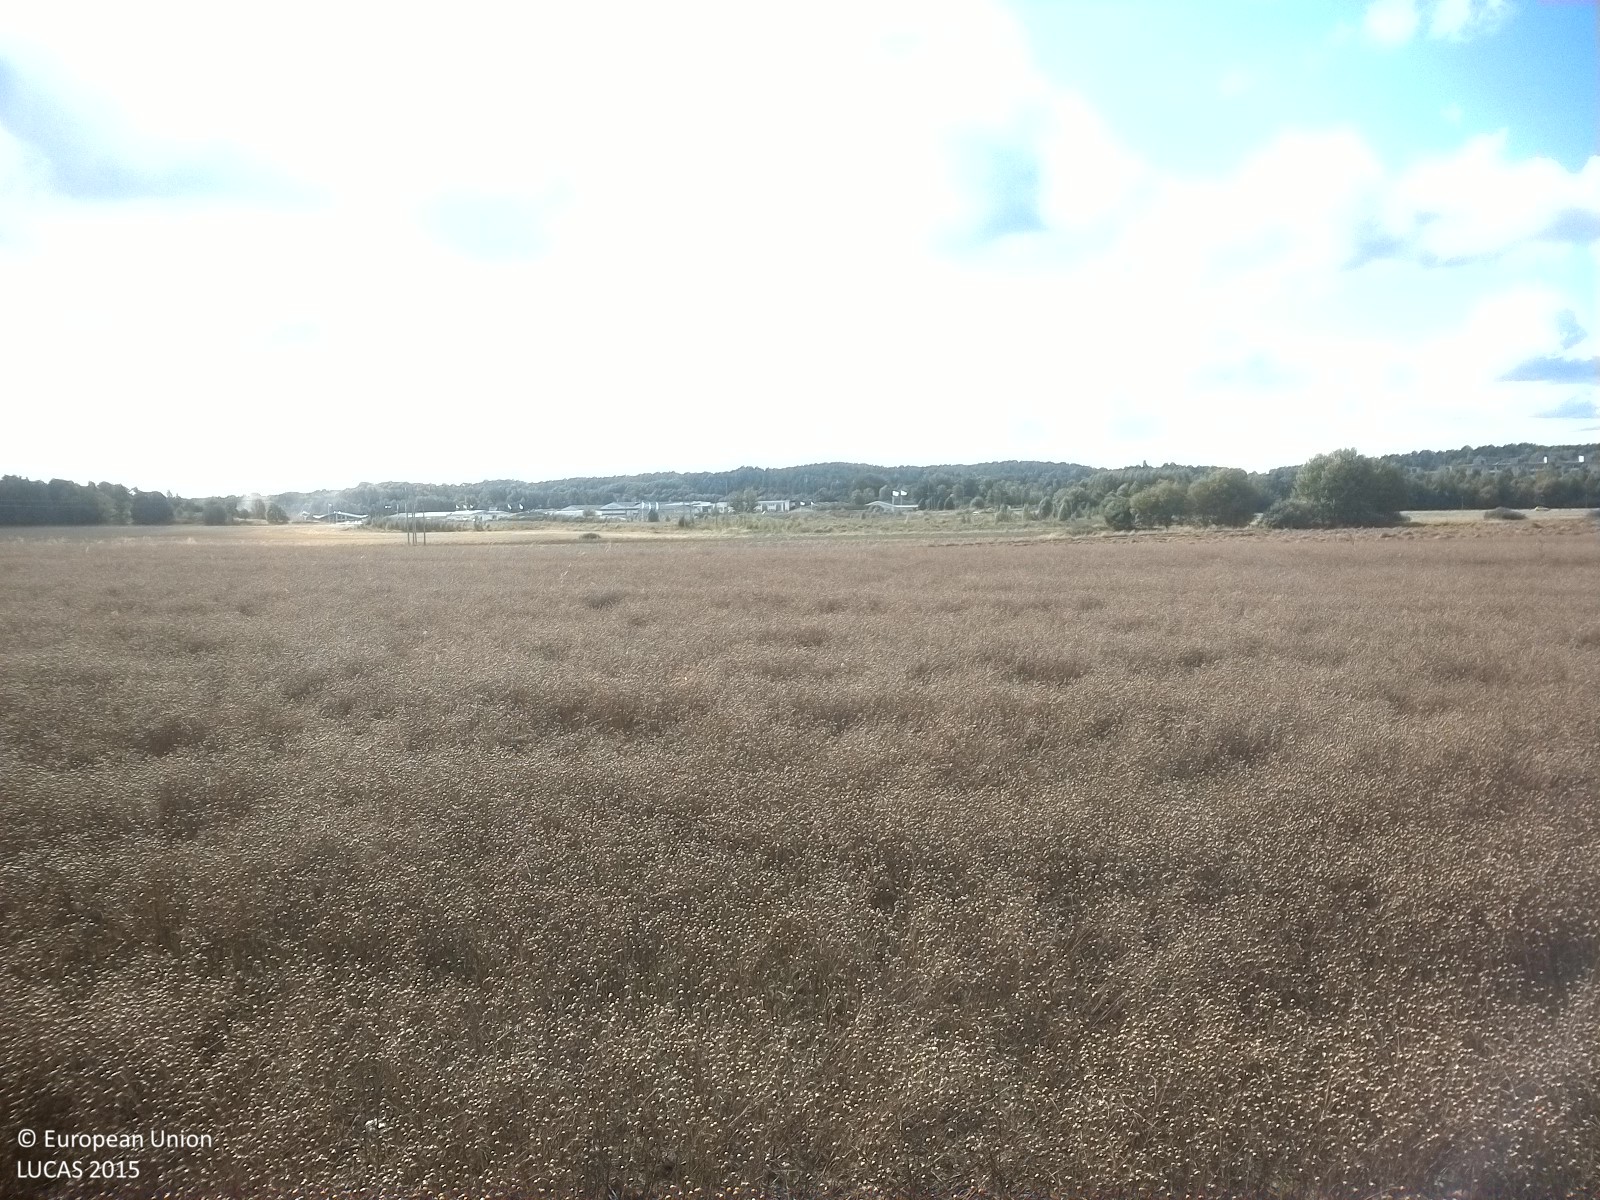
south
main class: Cropland
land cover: Other fibre and oleaginous crops
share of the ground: > 75 %
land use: Agriculture (excluding fallow land and kitchen gardens)
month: September
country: SE
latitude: 58.5622
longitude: 16.2351
